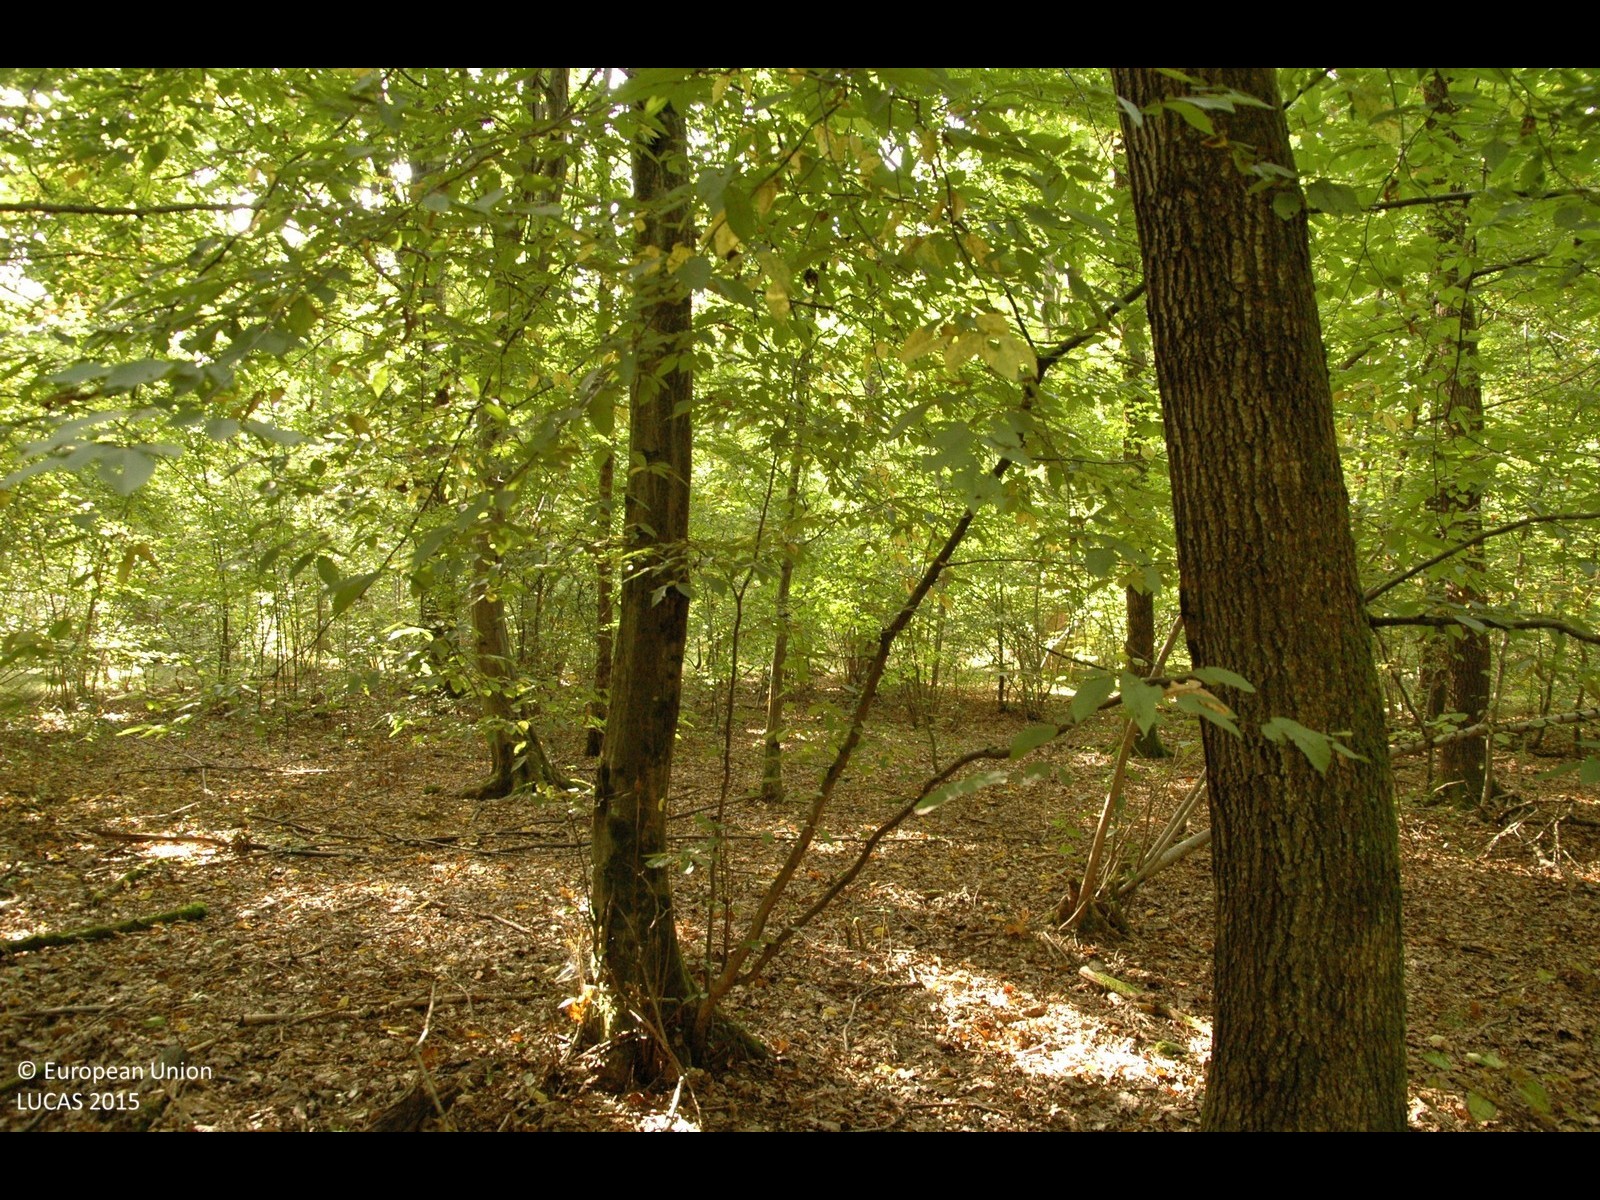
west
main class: Woodland
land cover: Broadleaved woodland
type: mesophytic deciduous forest
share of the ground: > 75 %
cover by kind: broadleaved forest trees 100 %
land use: Forestry
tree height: > 5 m
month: September
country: HR
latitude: 45.6803
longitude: 15.9418
